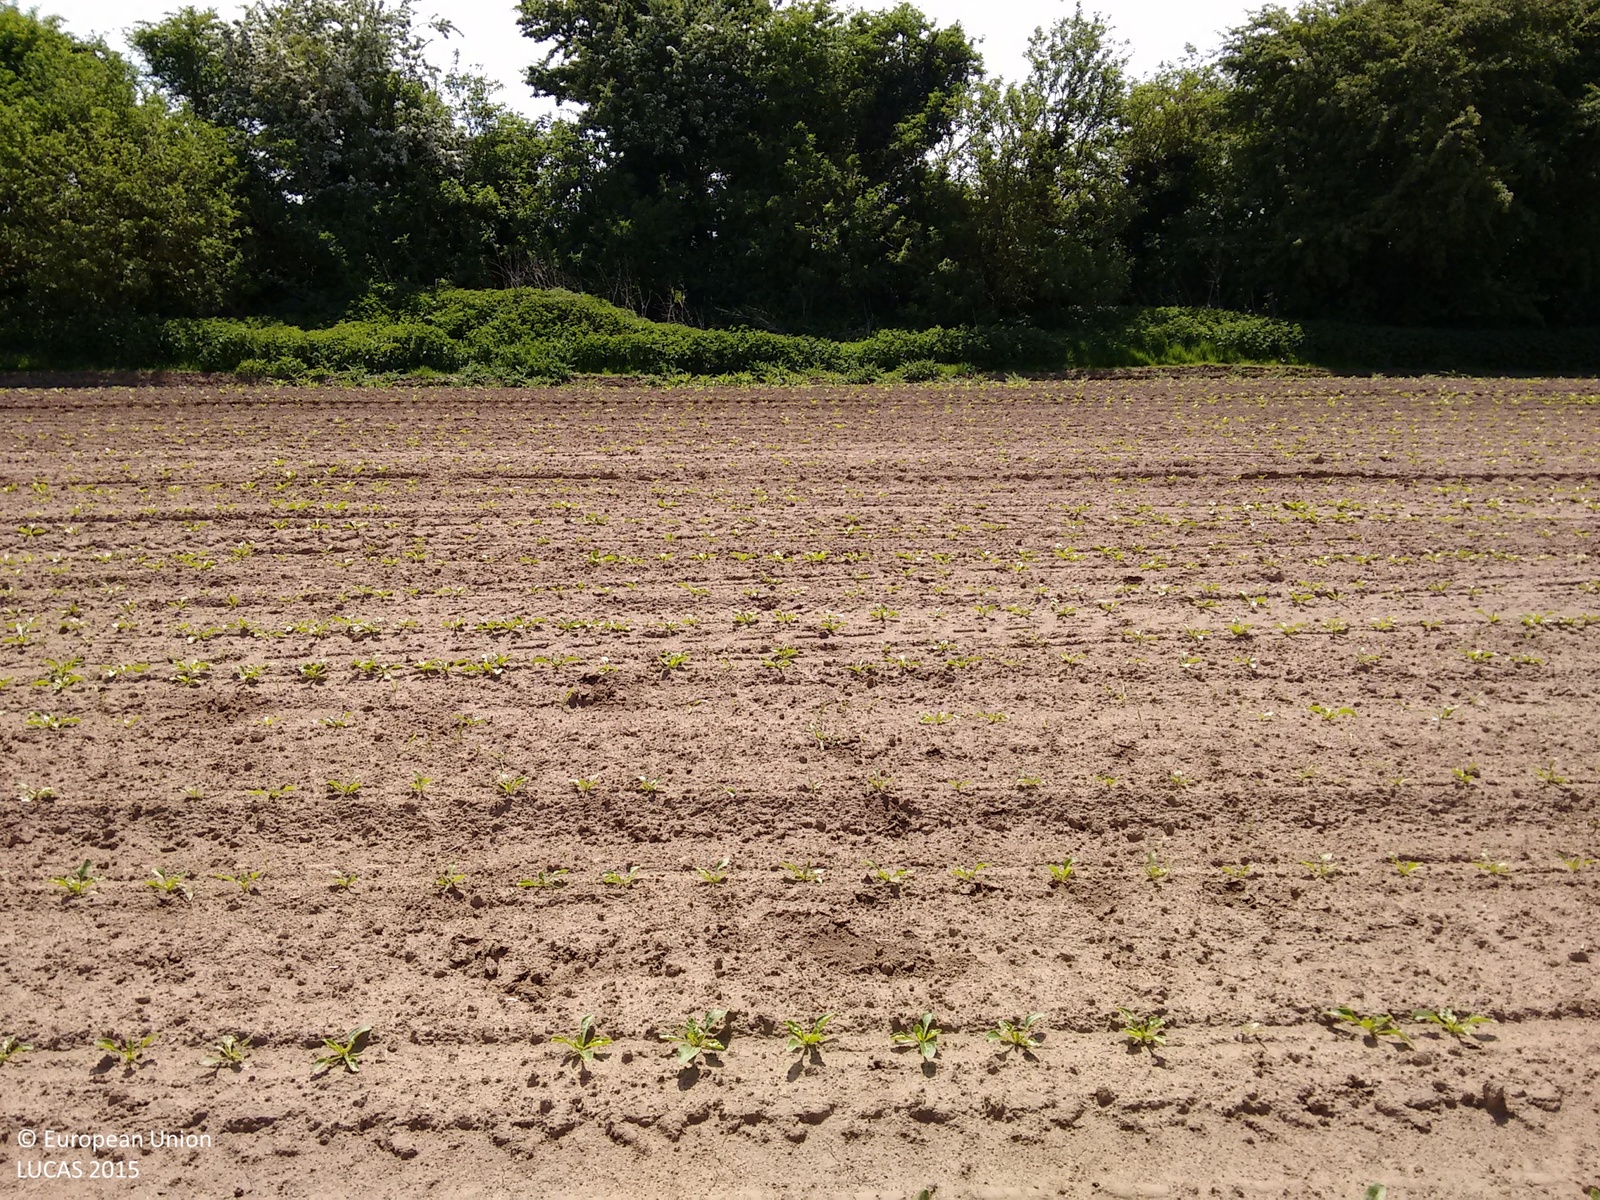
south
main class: Cropland
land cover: Sugar beet
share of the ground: < 10 %
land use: Agriculture (excluding fallow land and kitchen gardens)
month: May
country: GB
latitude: 52.8376
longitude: -0.0532
